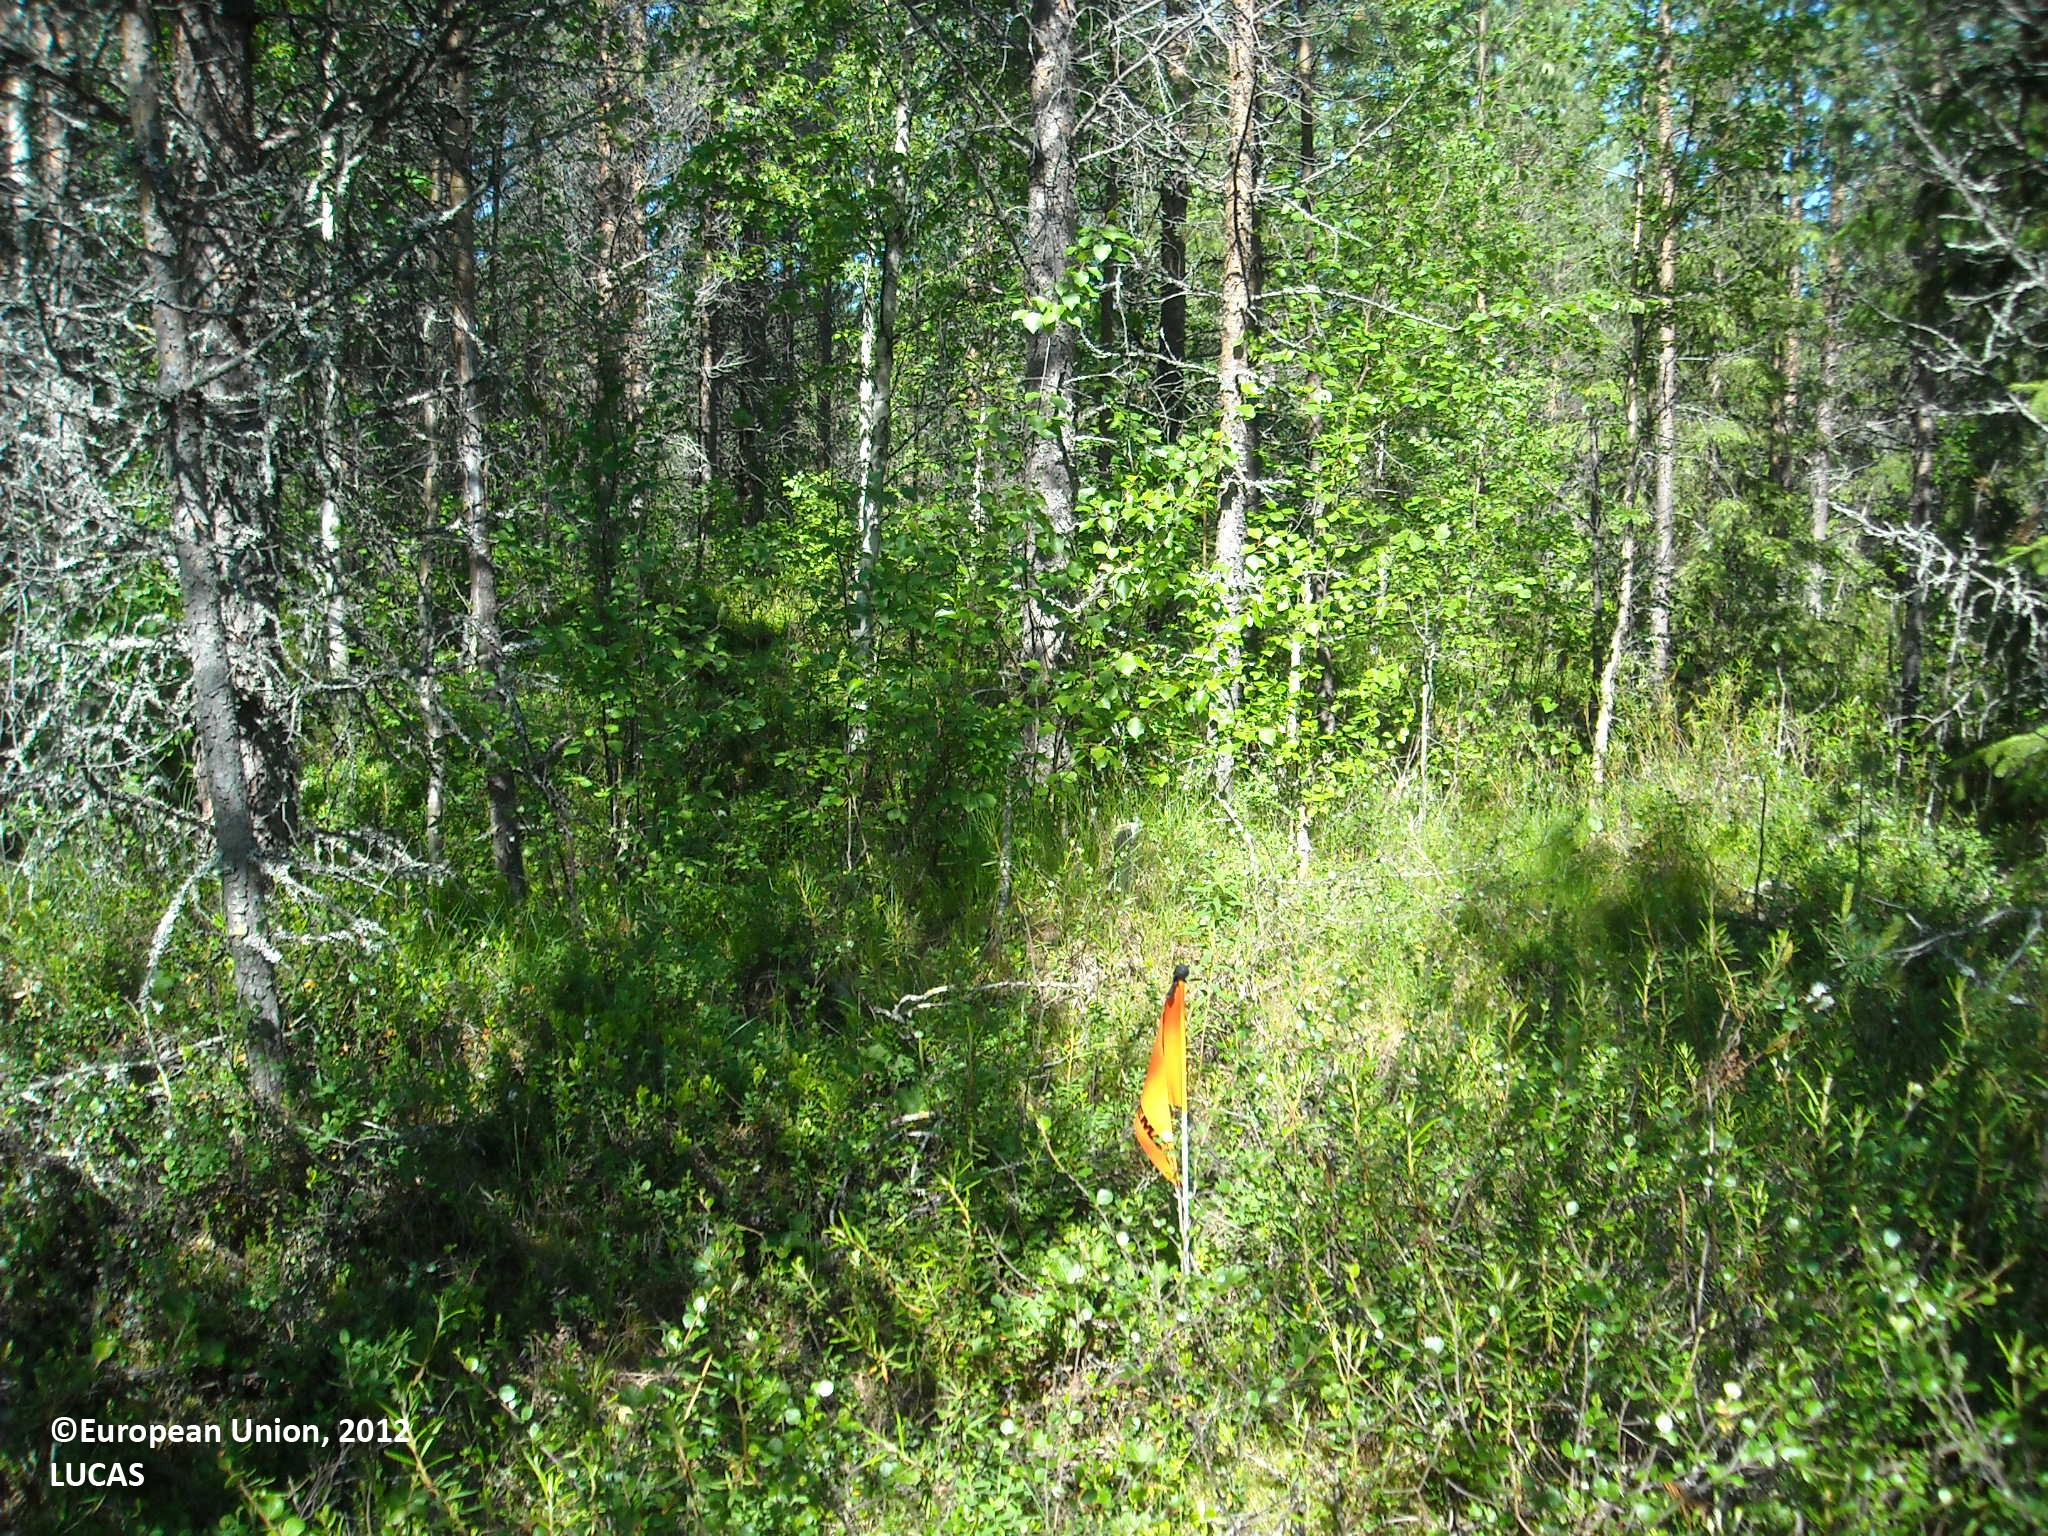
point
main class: Woodland
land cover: Other mixed woodland
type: boreal forest
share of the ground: > 75 %
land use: Forestry
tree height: > 5 m
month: July
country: FI
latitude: 64.9130
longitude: 27.4044
